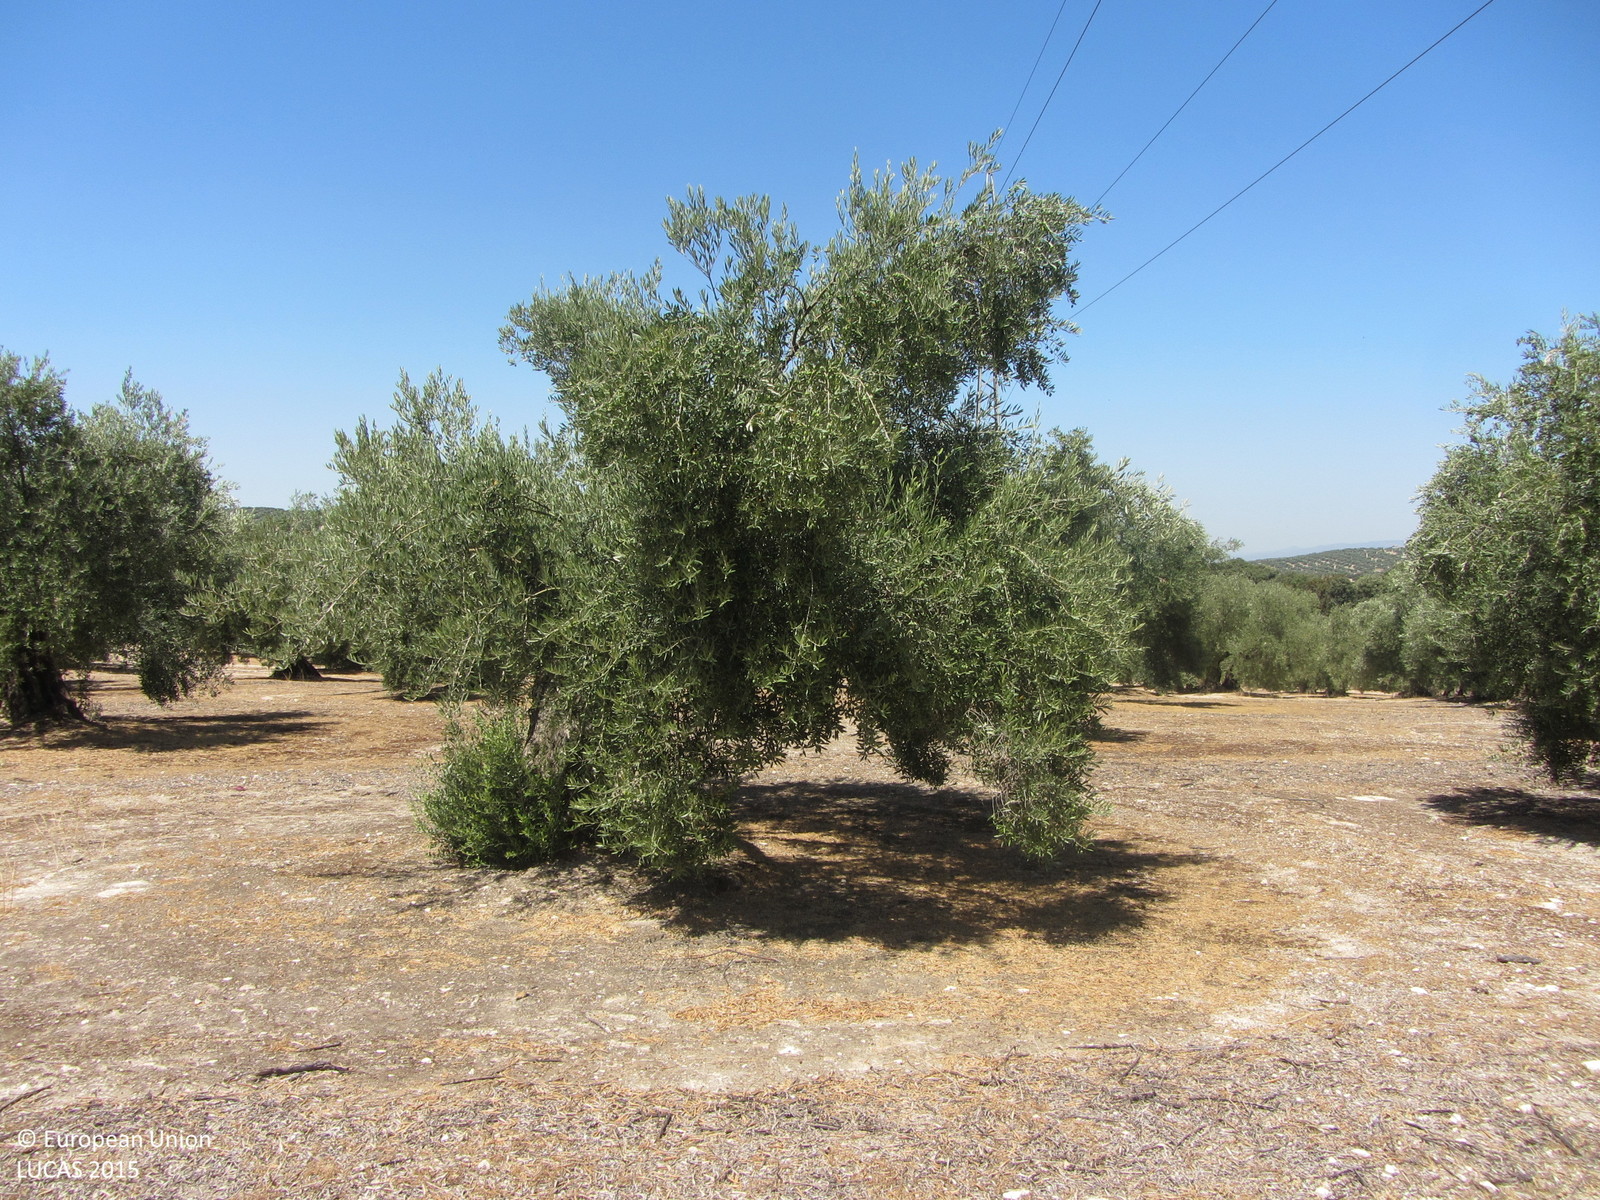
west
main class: Cropland
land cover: Olive groves
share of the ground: 25 - 50 %
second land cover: Other bare soil
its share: > 75 %
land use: Agriculture (excluding fallow land and kitchen gardens)
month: July
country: ES
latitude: 37.9972
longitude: -3.8405
